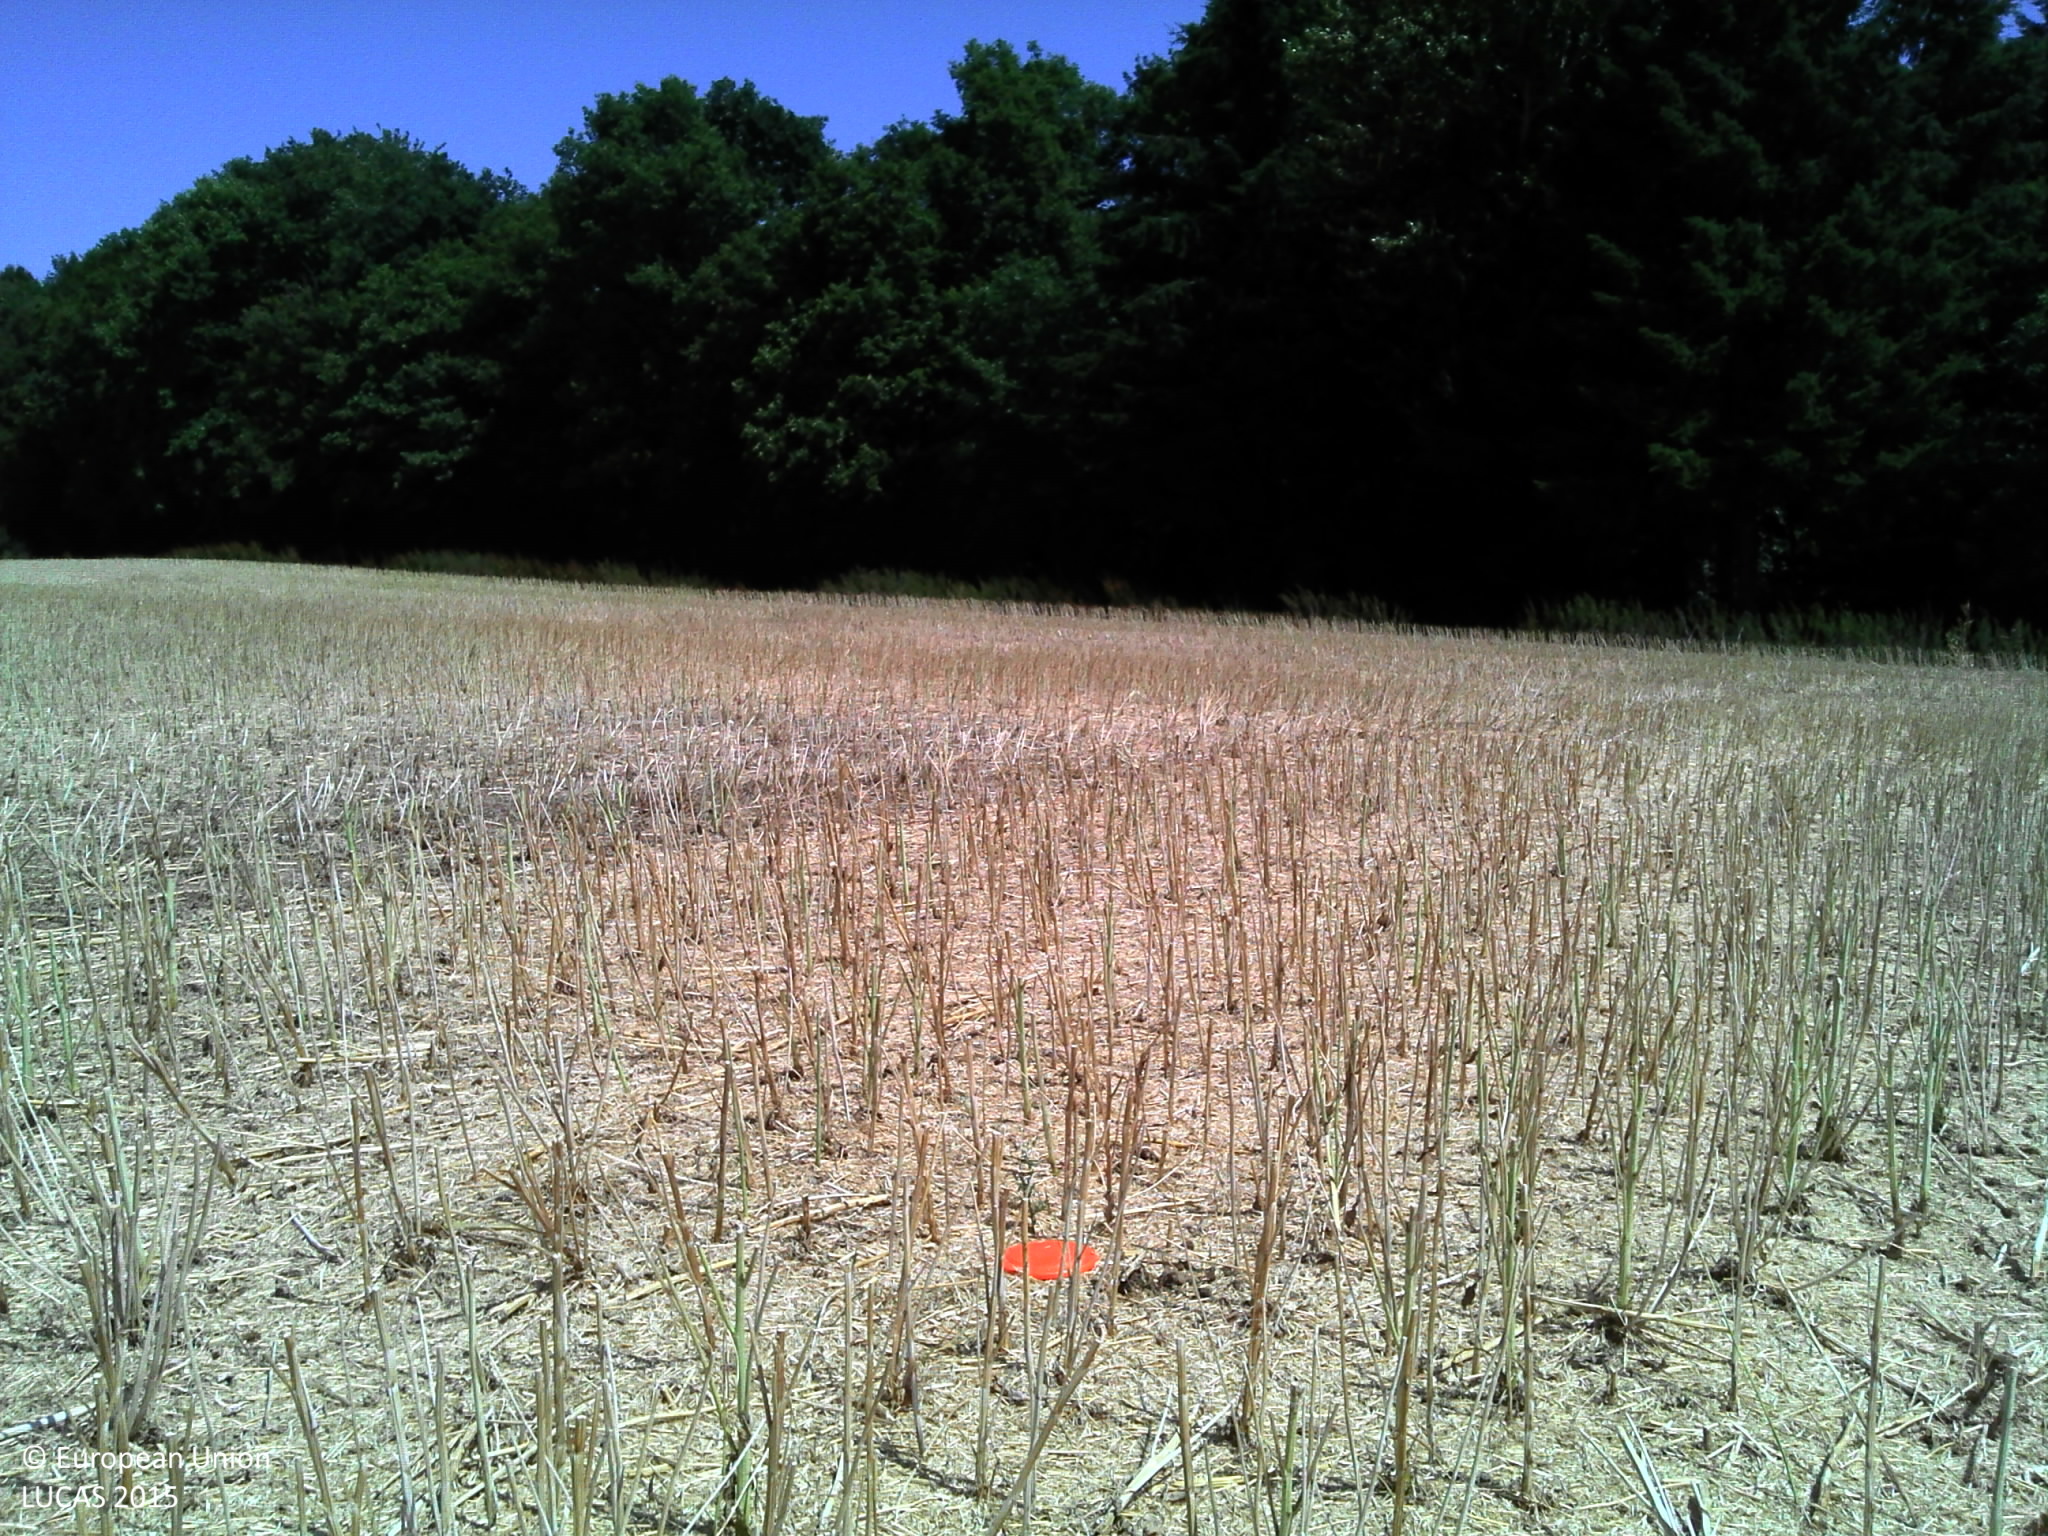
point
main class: Cropland
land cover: Rape and turnip rape
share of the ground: > 75 %
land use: Agriculture (excluding fallow land and kitchen gardens)
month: July
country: FR
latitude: 48.2377
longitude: 3.0314
